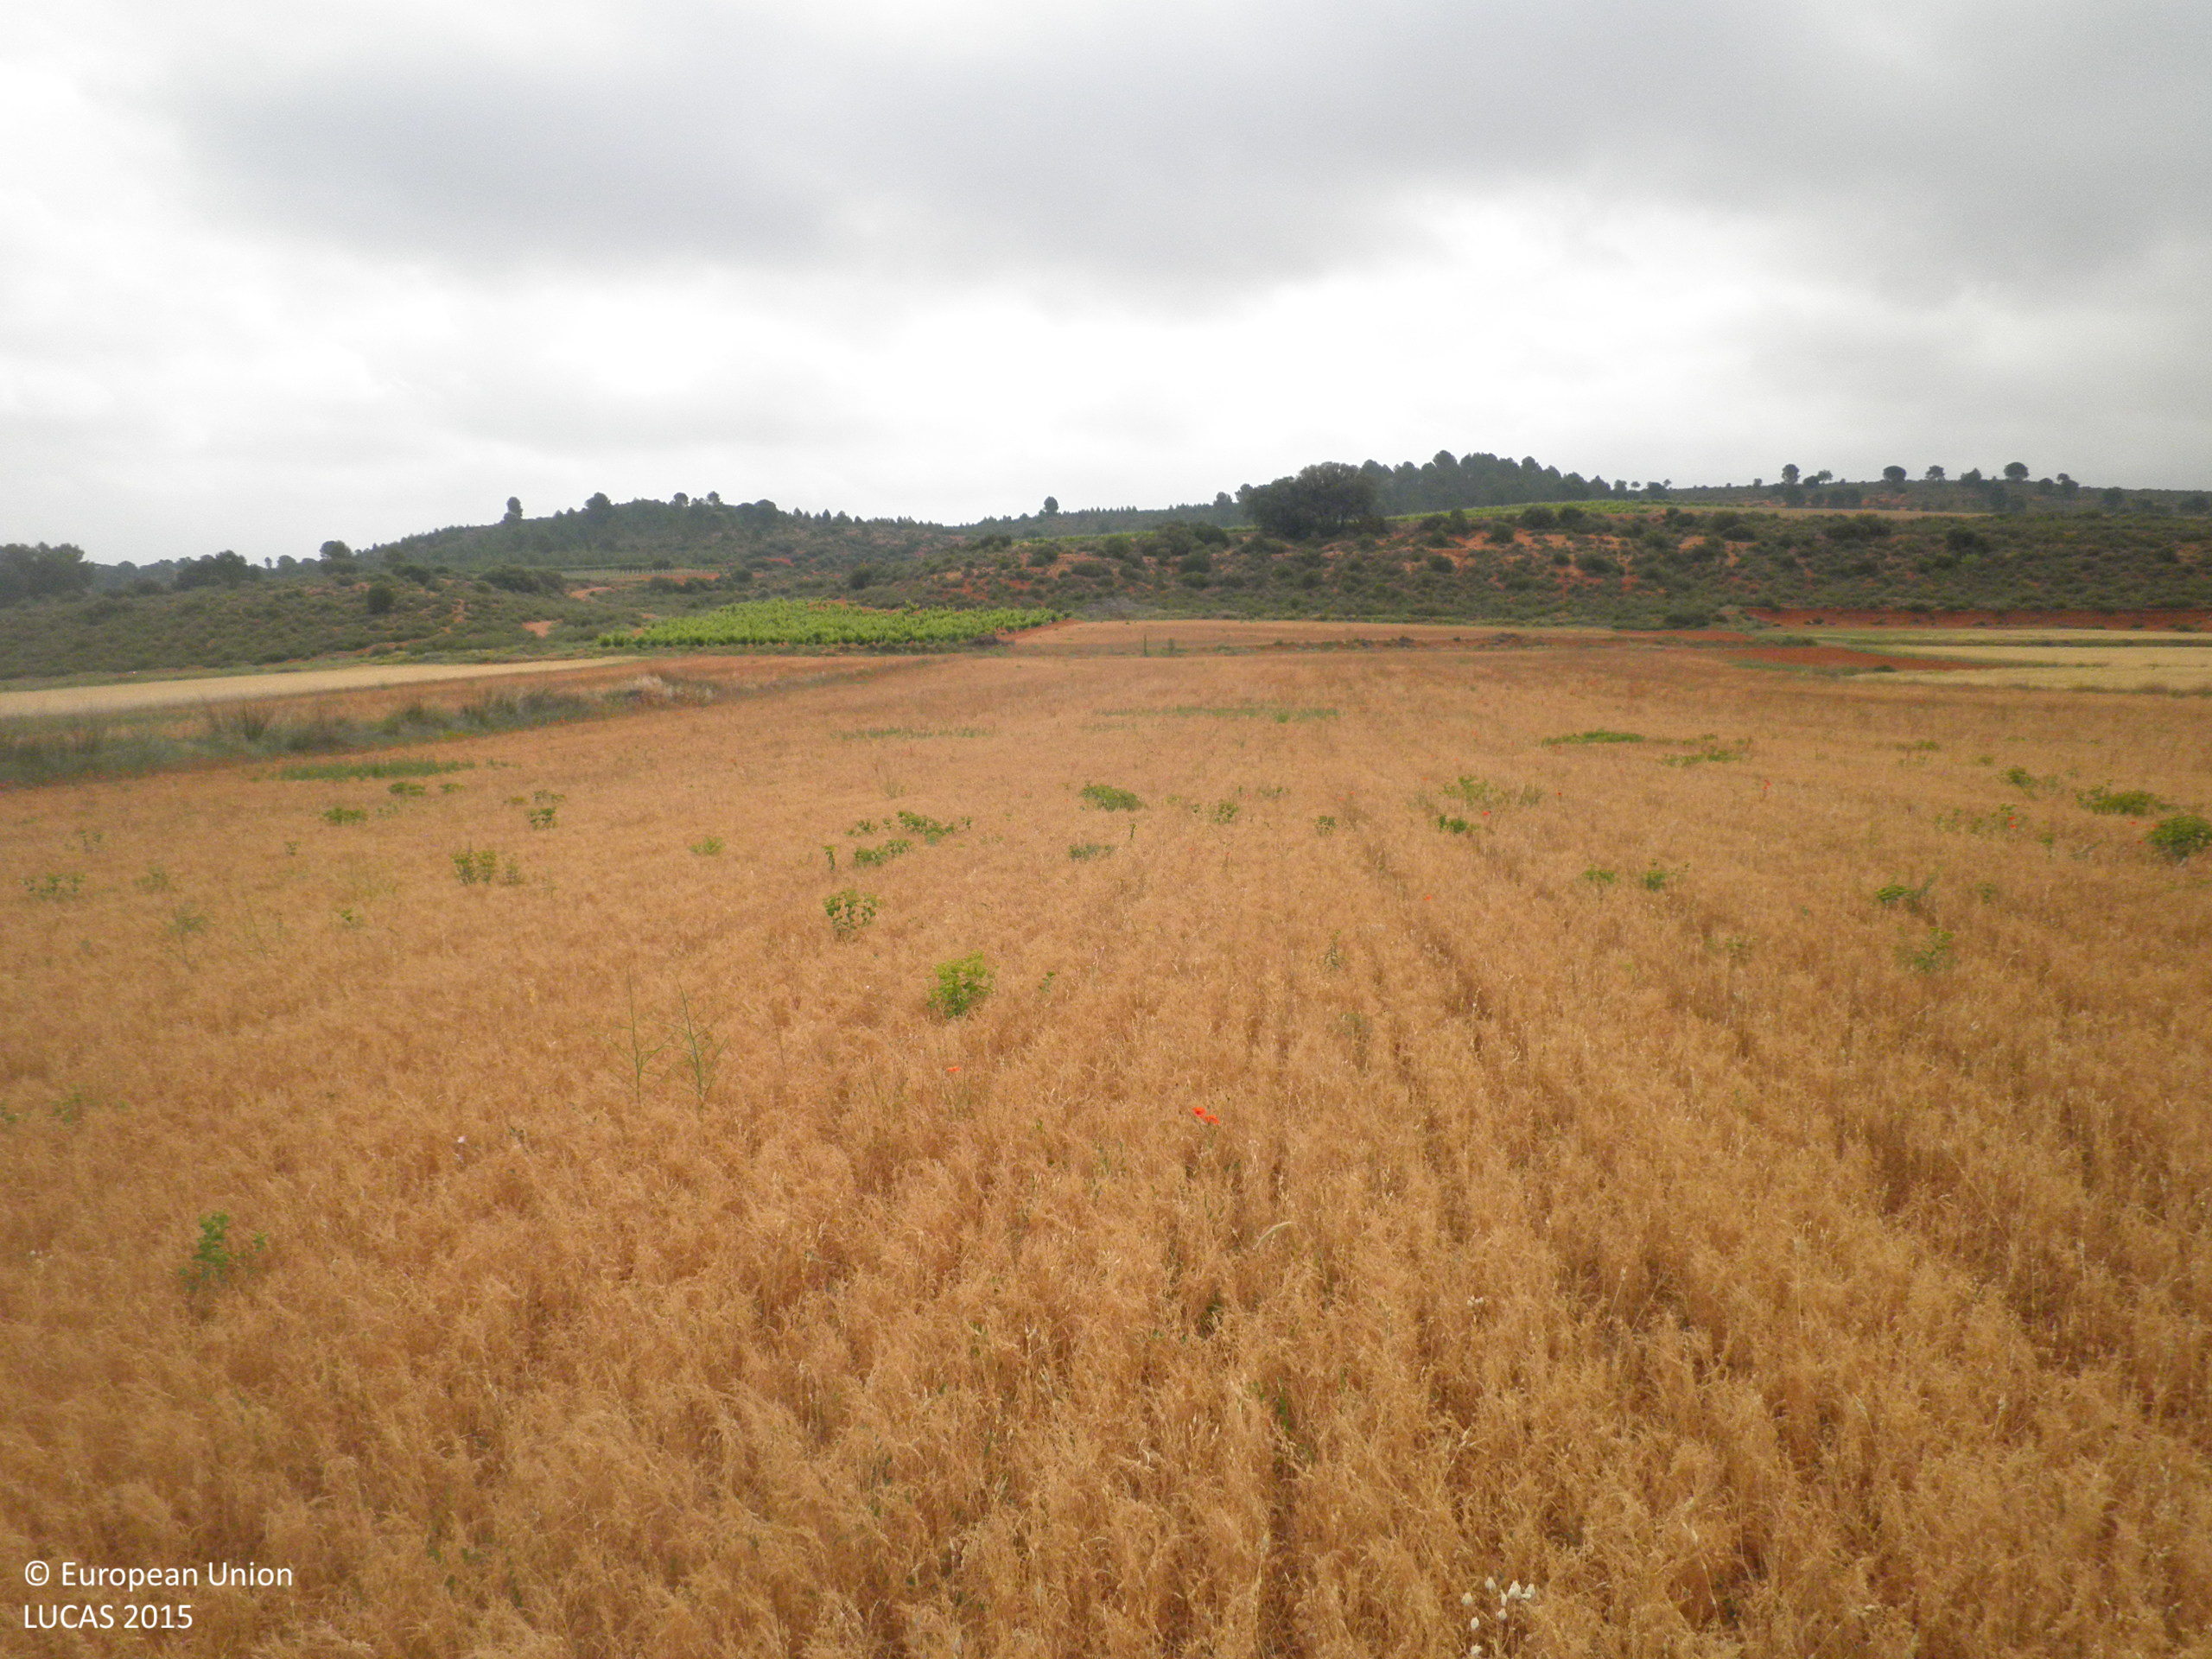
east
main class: Cropland
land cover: Dry pulses
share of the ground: > 75 %
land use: Agriculture (excluding fallow land and kitchen gardens)
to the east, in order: Dry pulses; Grass margins; Tracks; Grass margins; Vineyards; Shrubland without tree cover
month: June
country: ES
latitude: 39.5380
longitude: -1.7697
